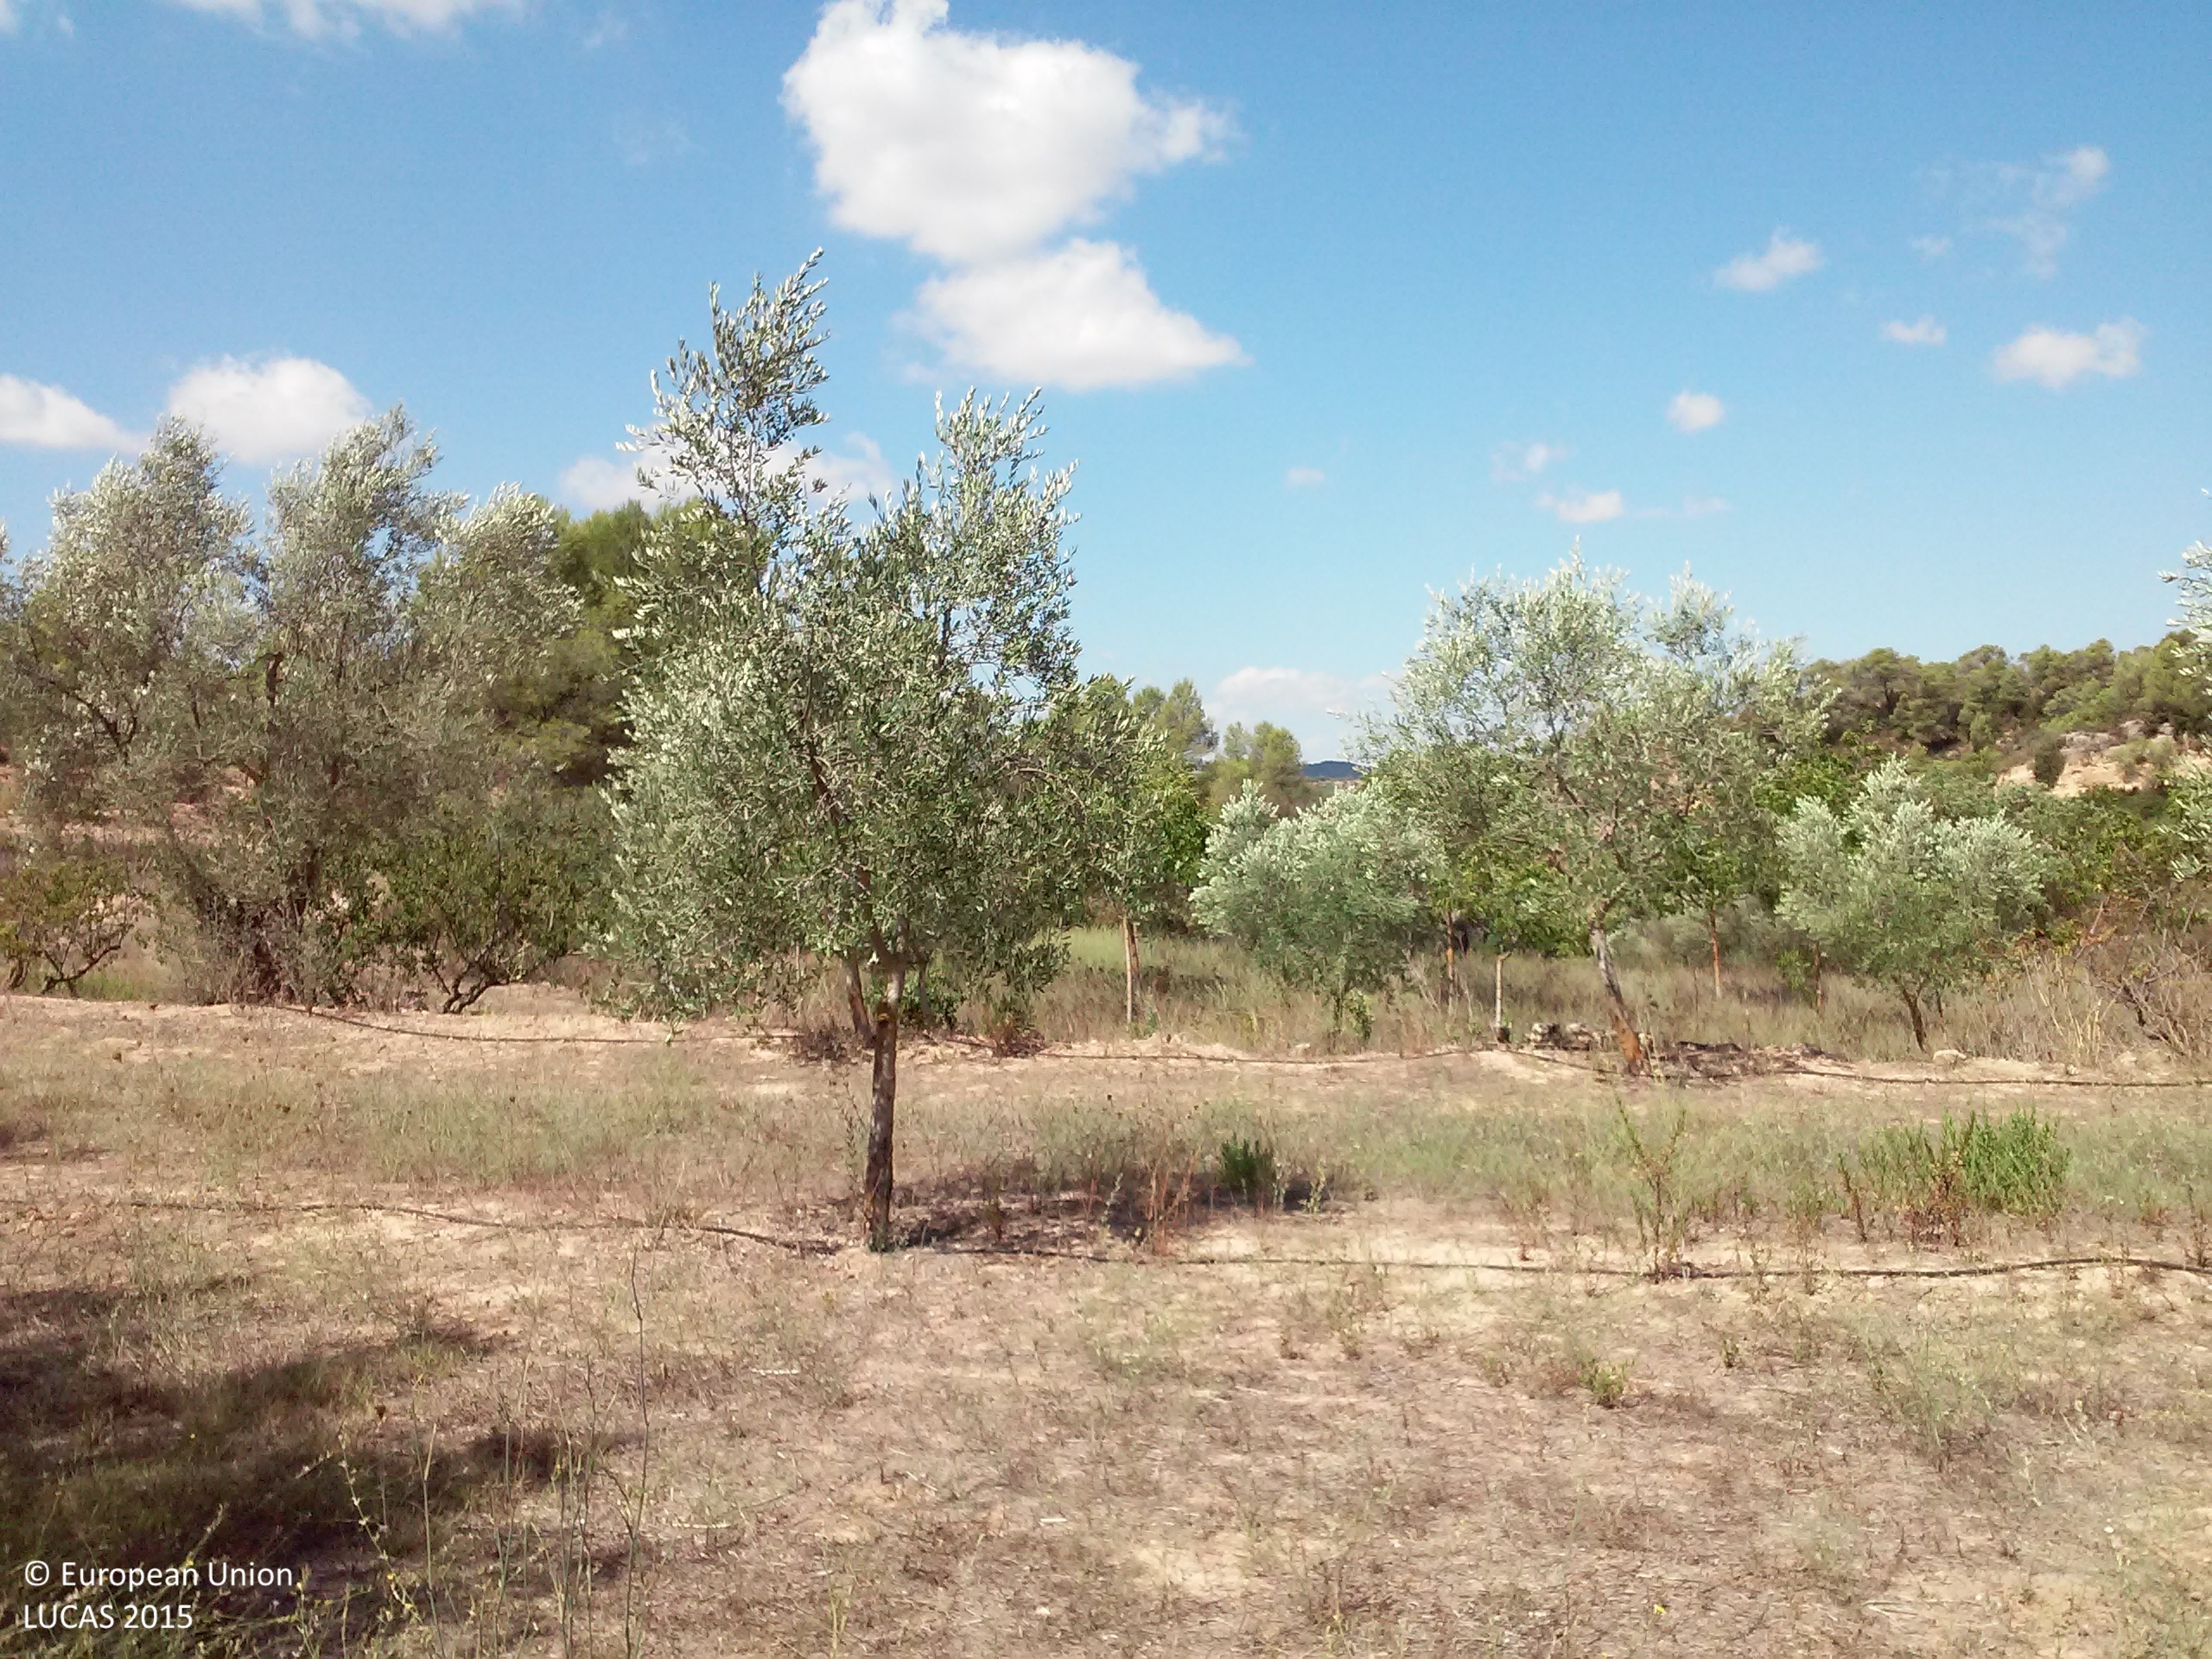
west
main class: Cropland
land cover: Olive groves
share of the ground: 10 - 25 %
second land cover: Other bare soil
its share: > 75 %
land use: Agriculture (excluding fallow land and kitchen gardens)
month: August
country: ES
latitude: 41.2927
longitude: 0.6402
